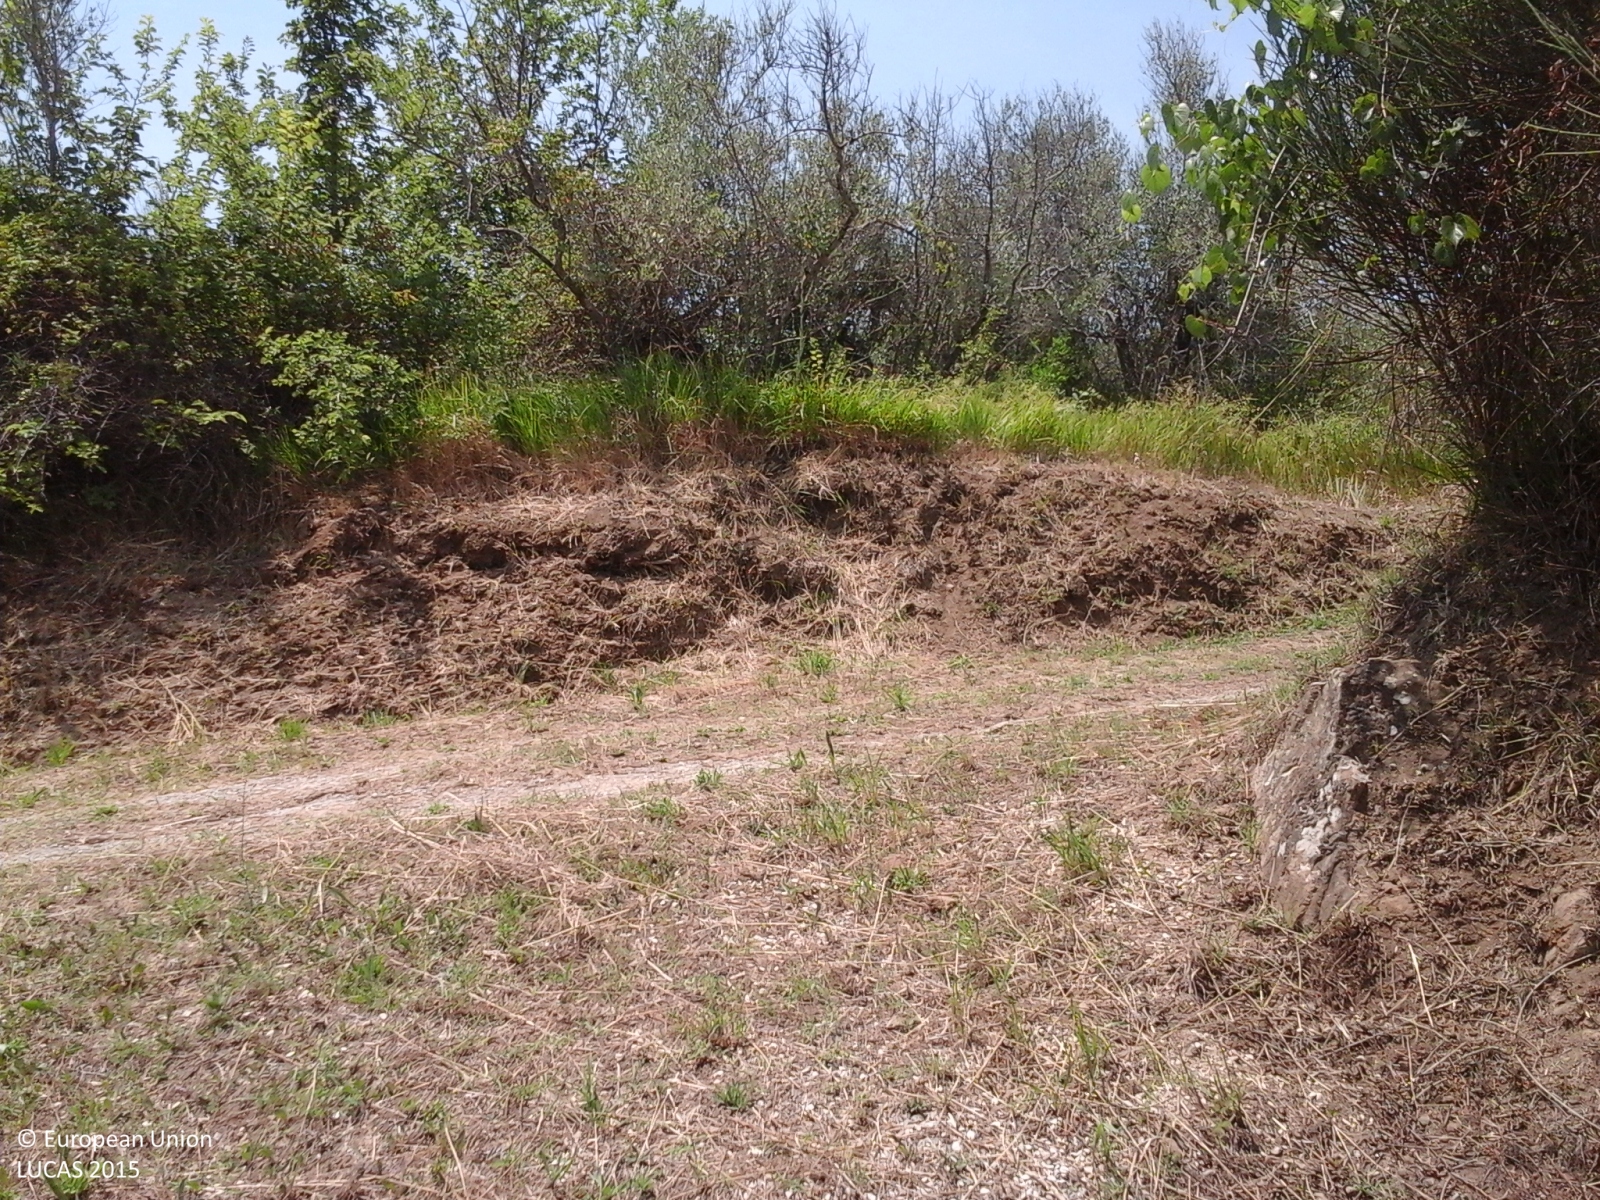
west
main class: Woodland
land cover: Broadleaved woodland
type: thermophilous deciduous forest
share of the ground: 25 - 50 %
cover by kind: broadleaved forest trees 70 %, herbaceous plants 20 %, shrubs 10 %
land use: Semi-natural and natural areas not in use
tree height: < 5 m
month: June
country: IT
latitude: 41.8507
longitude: 12.9881
